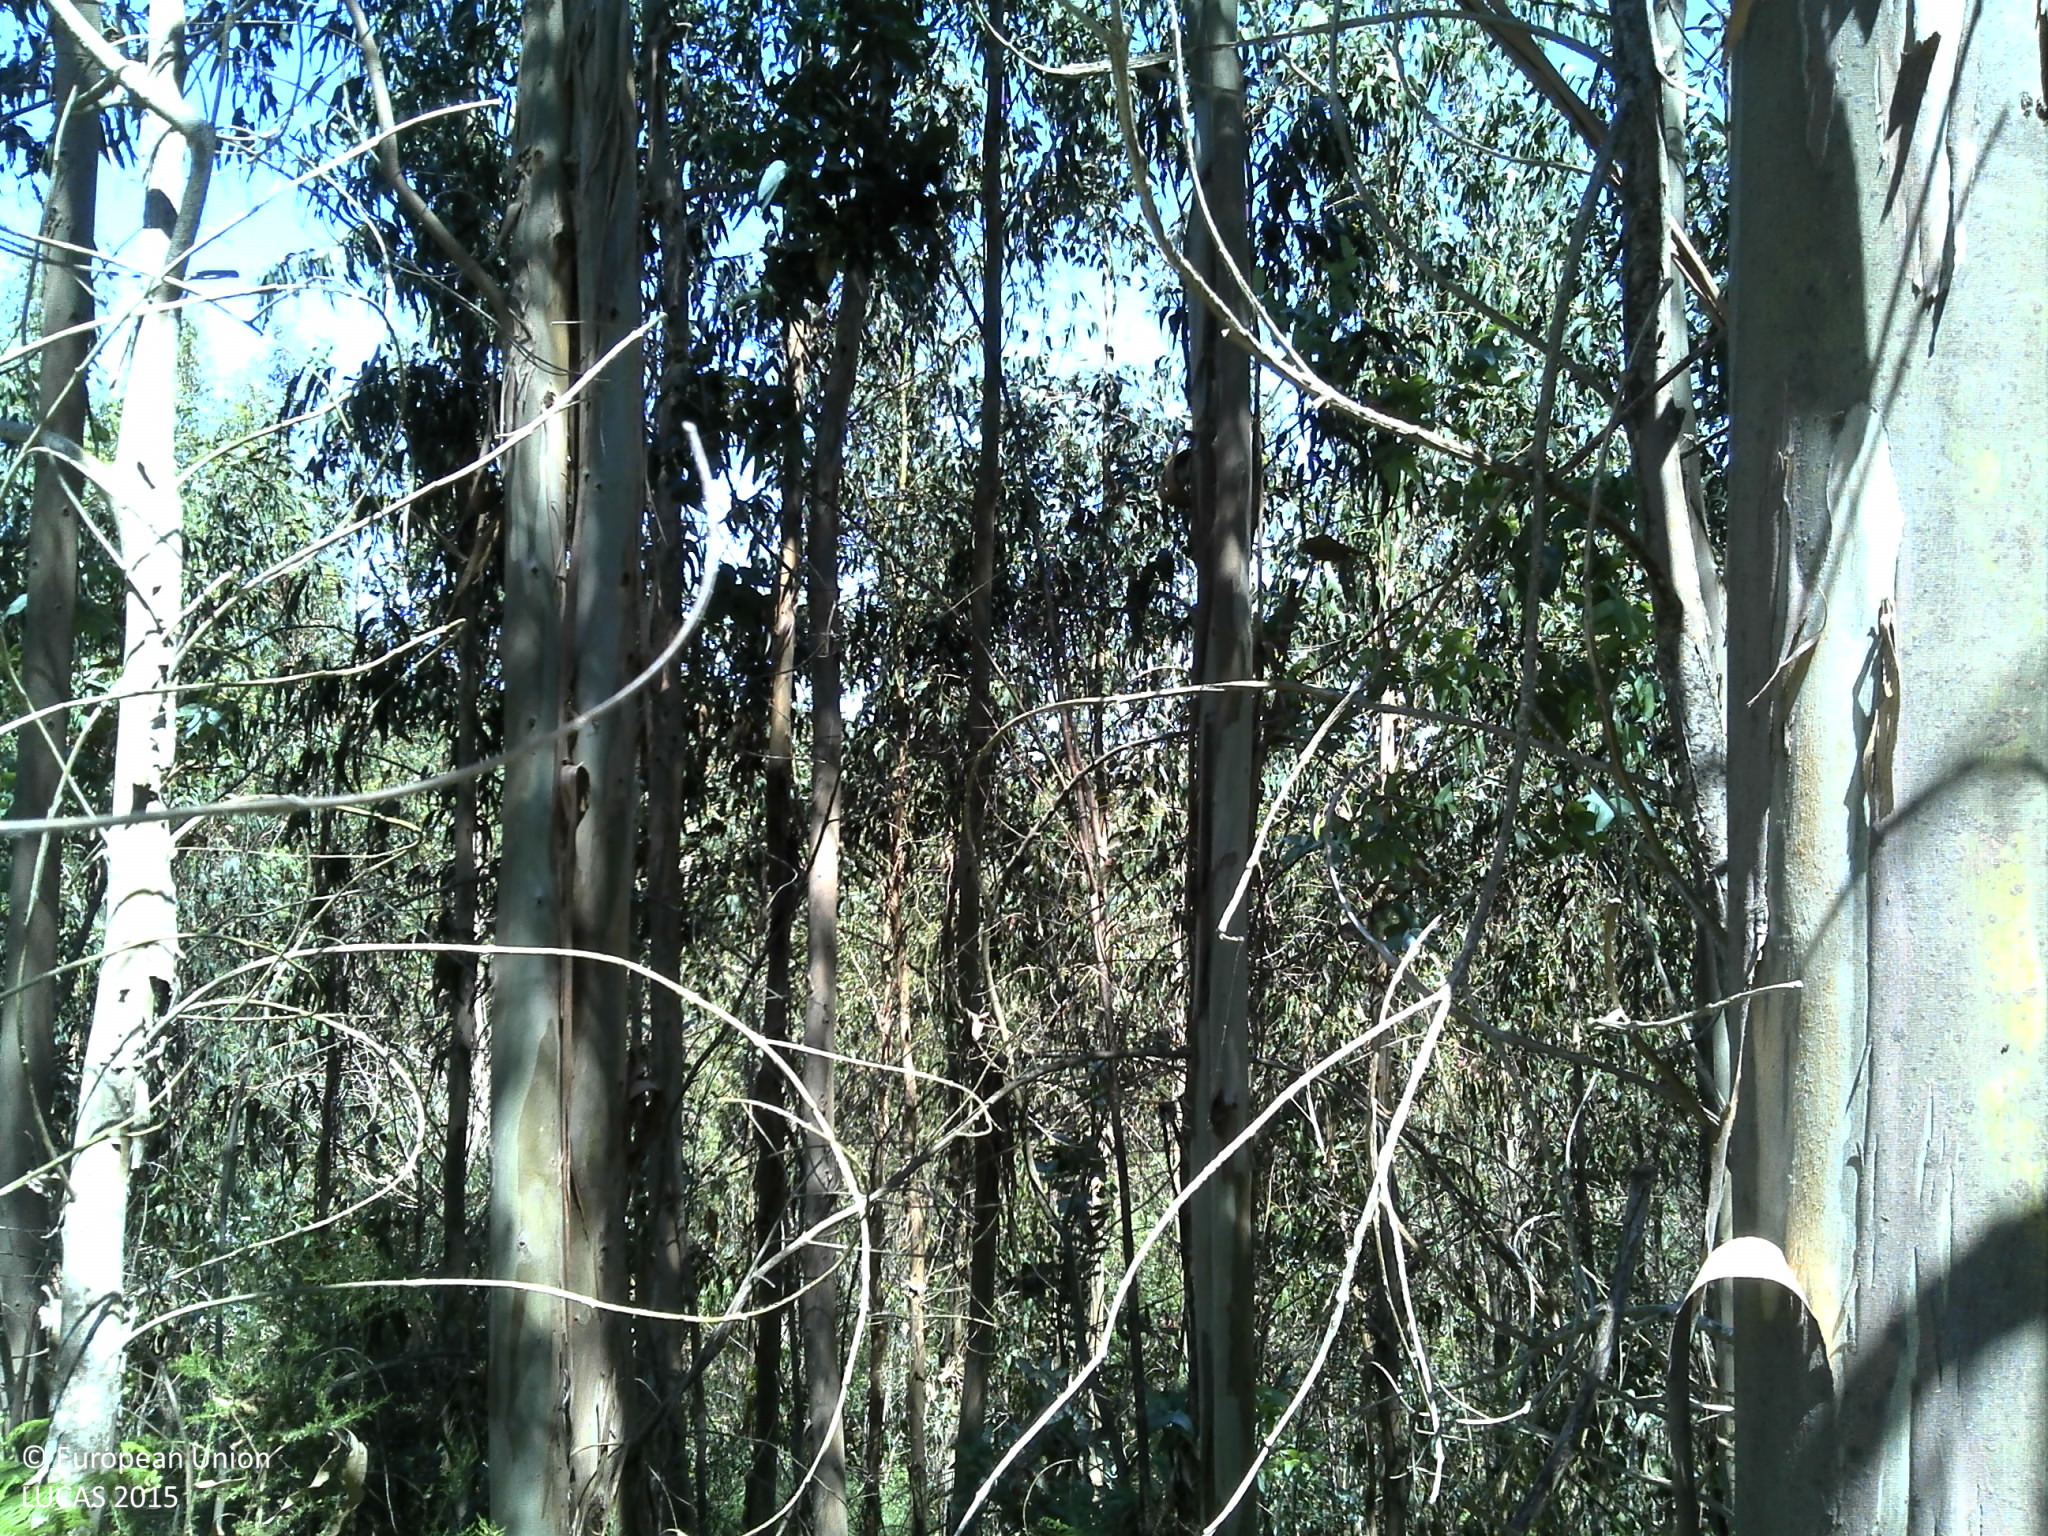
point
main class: Woodland
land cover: Broadleaved woodland
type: exotic forest
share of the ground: > 75 %
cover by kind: broadleaved forest trees 80 %, shrubs 15 %, herbaceous plants 5 %
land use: Forestry
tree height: > 5 m
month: May
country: PT
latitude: 41.8499
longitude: -8.7286
